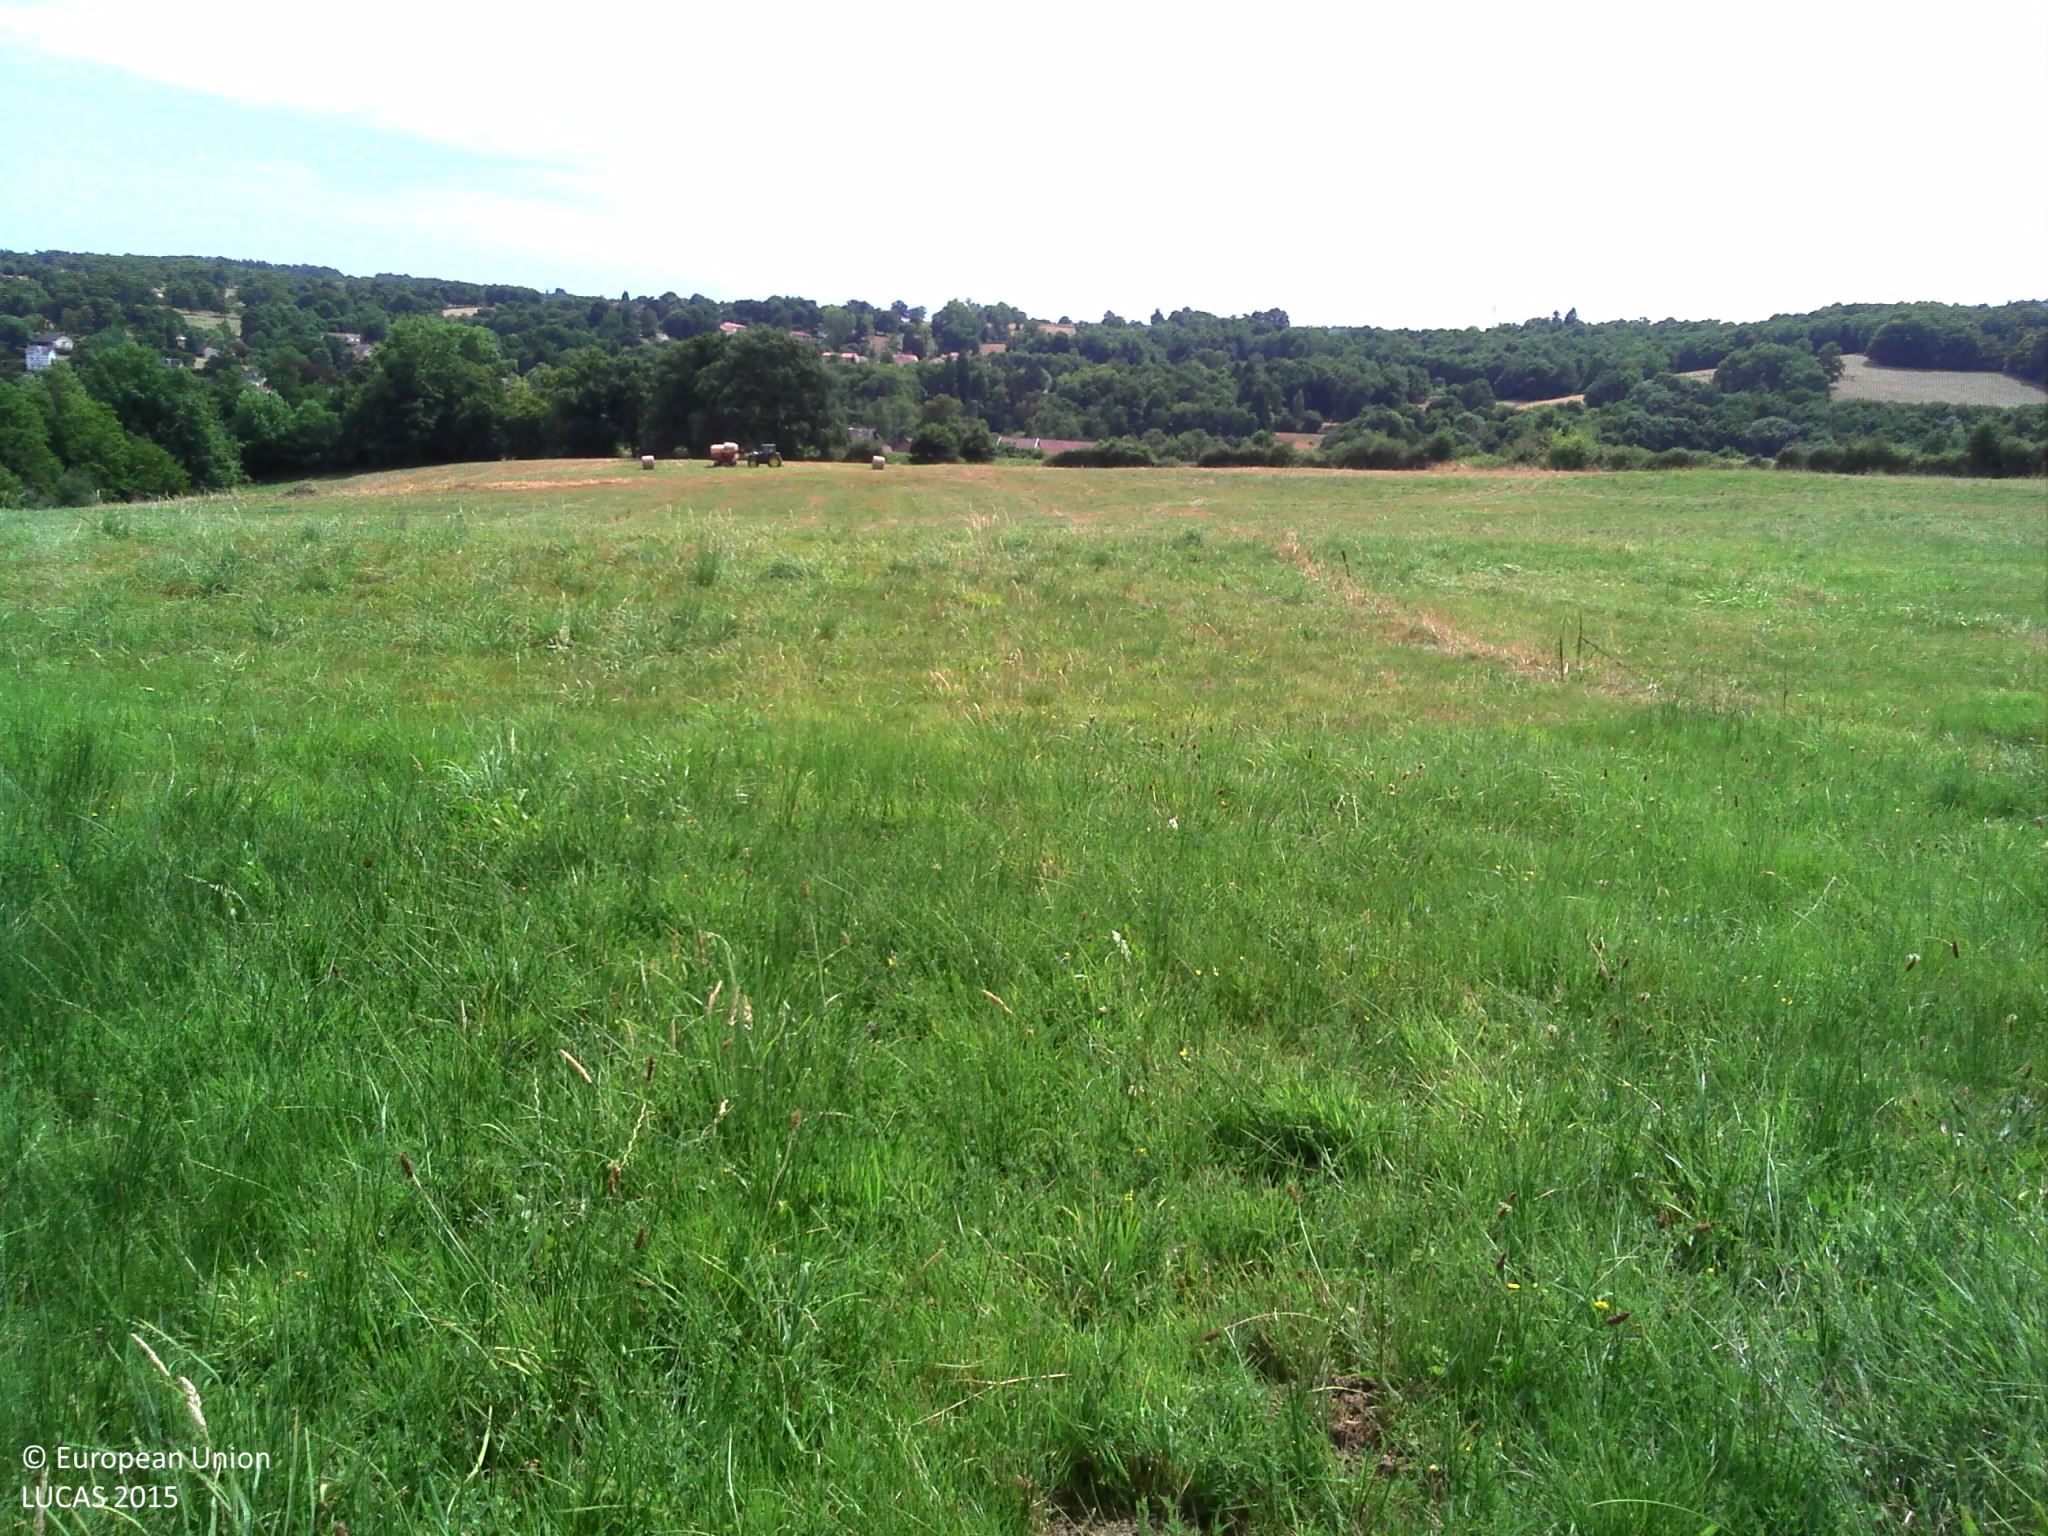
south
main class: Grassland
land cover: Grassland without tree/shrub cover
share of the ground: > 75 %
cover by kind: herbaceous plants 100 %
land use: Agriculture (excluding fallow land and kitchen gardens)
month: July
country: FR
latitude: 45.8813
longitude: 1.0082
